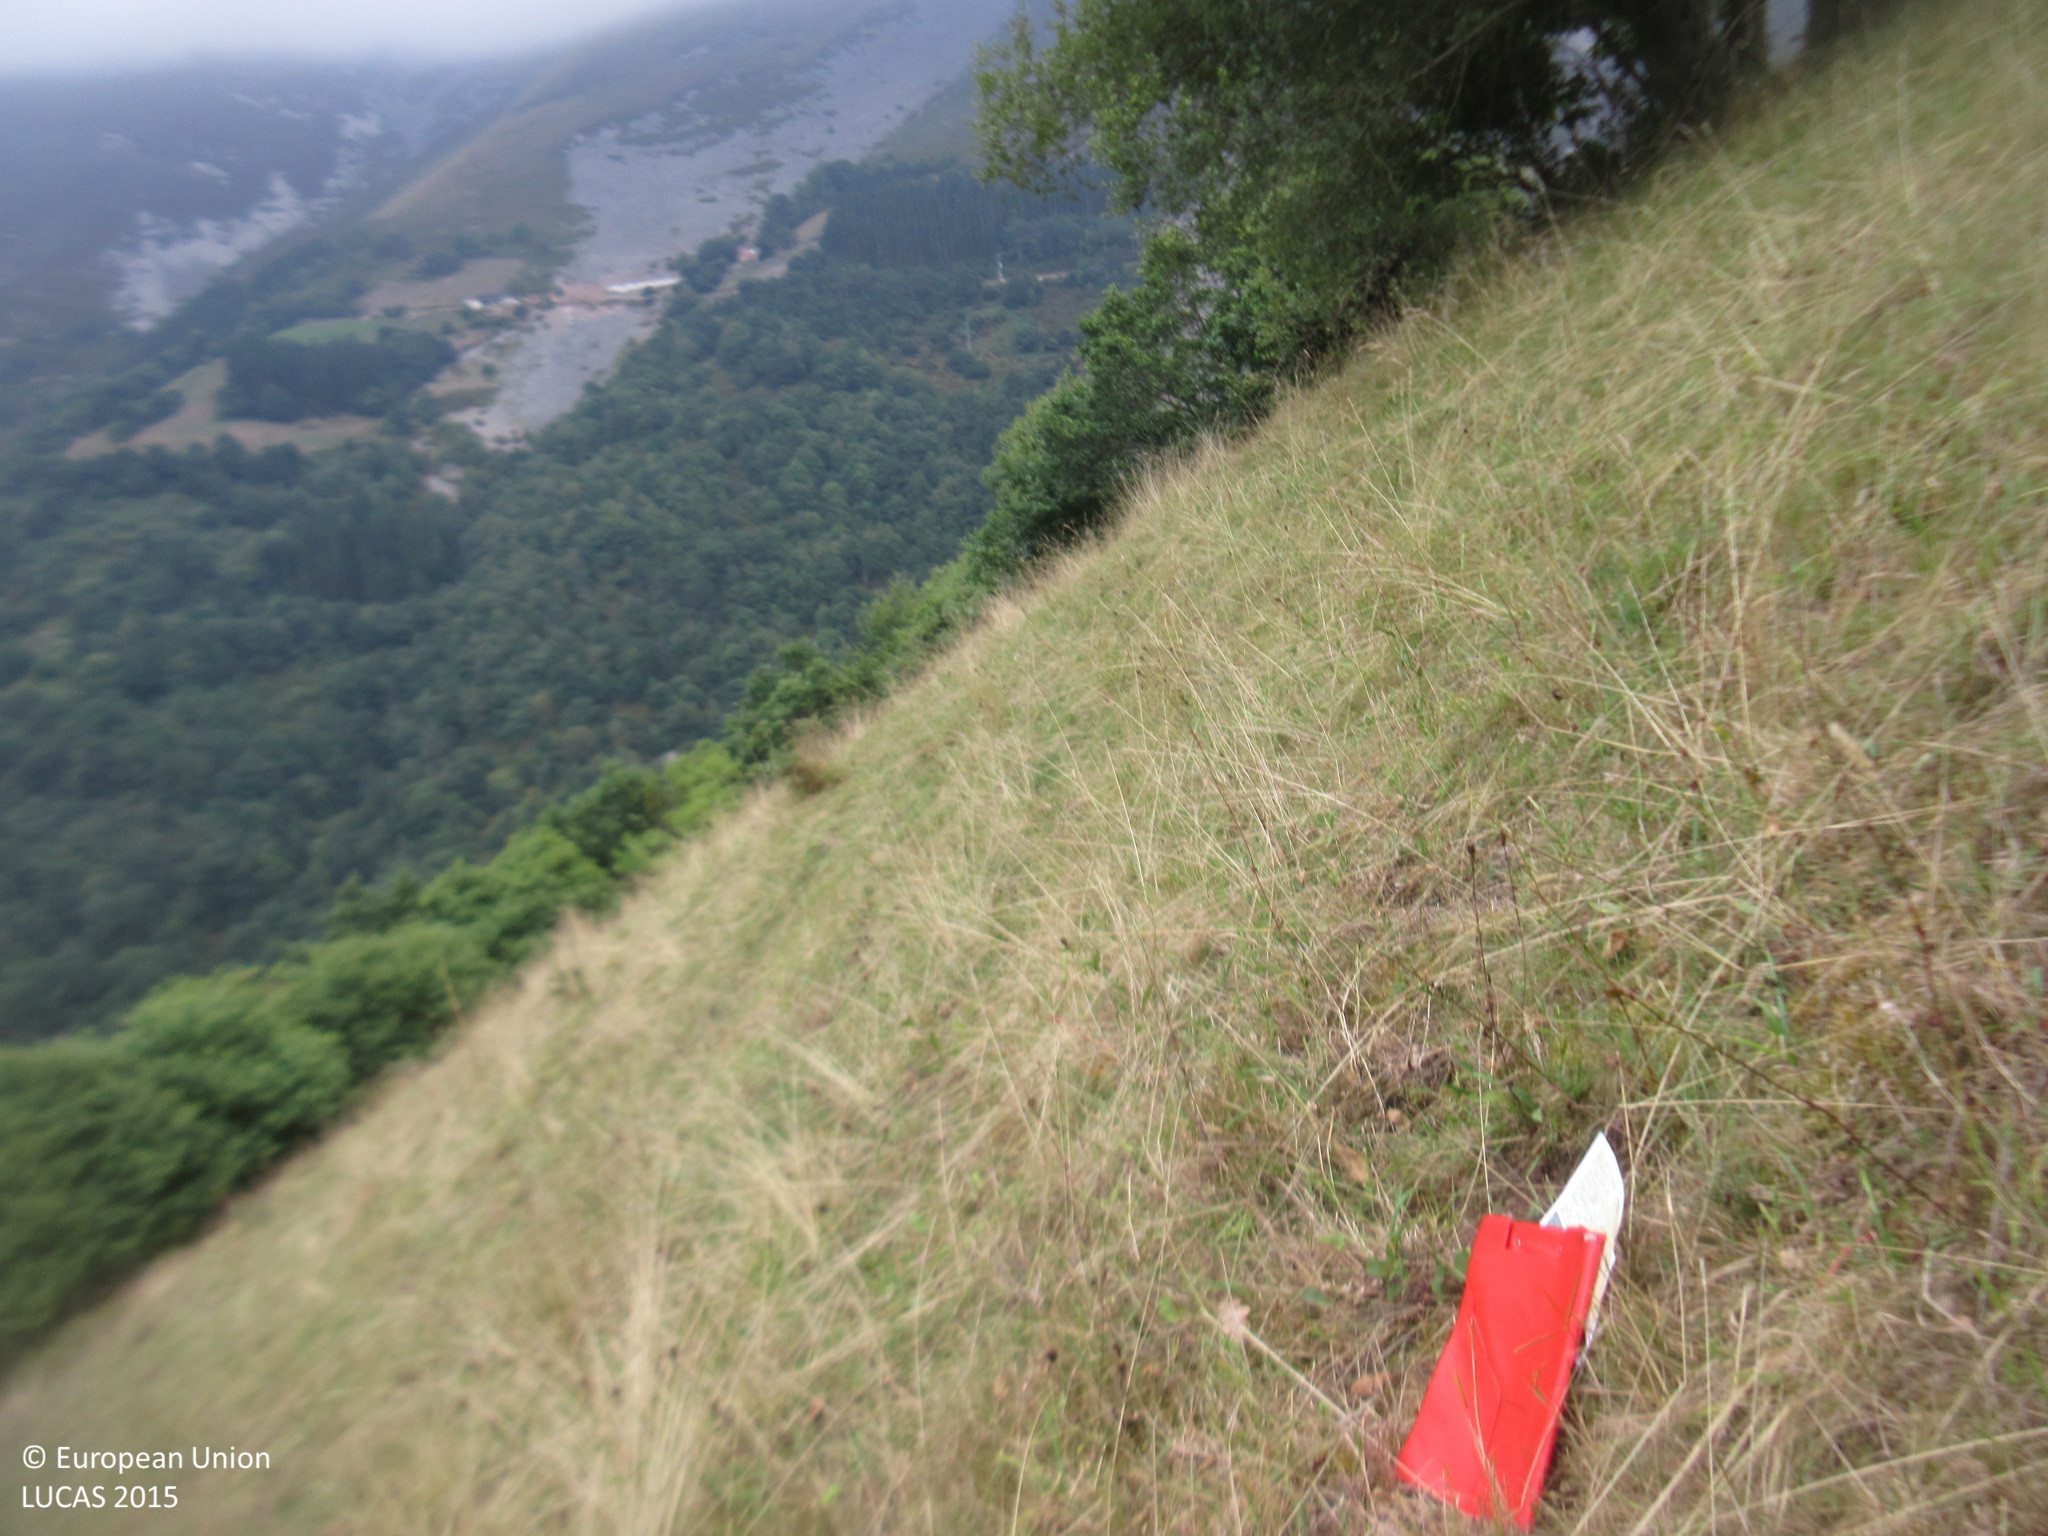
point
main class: Grassland
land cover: Grassland without tree/shrub cover
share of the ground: > 75 %
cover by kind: herbaceous plants 100 %
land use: Agriculture (excluding fallow land and kitchen gardens)
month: August
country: ES
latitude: 43.3610
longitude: -6.6537
